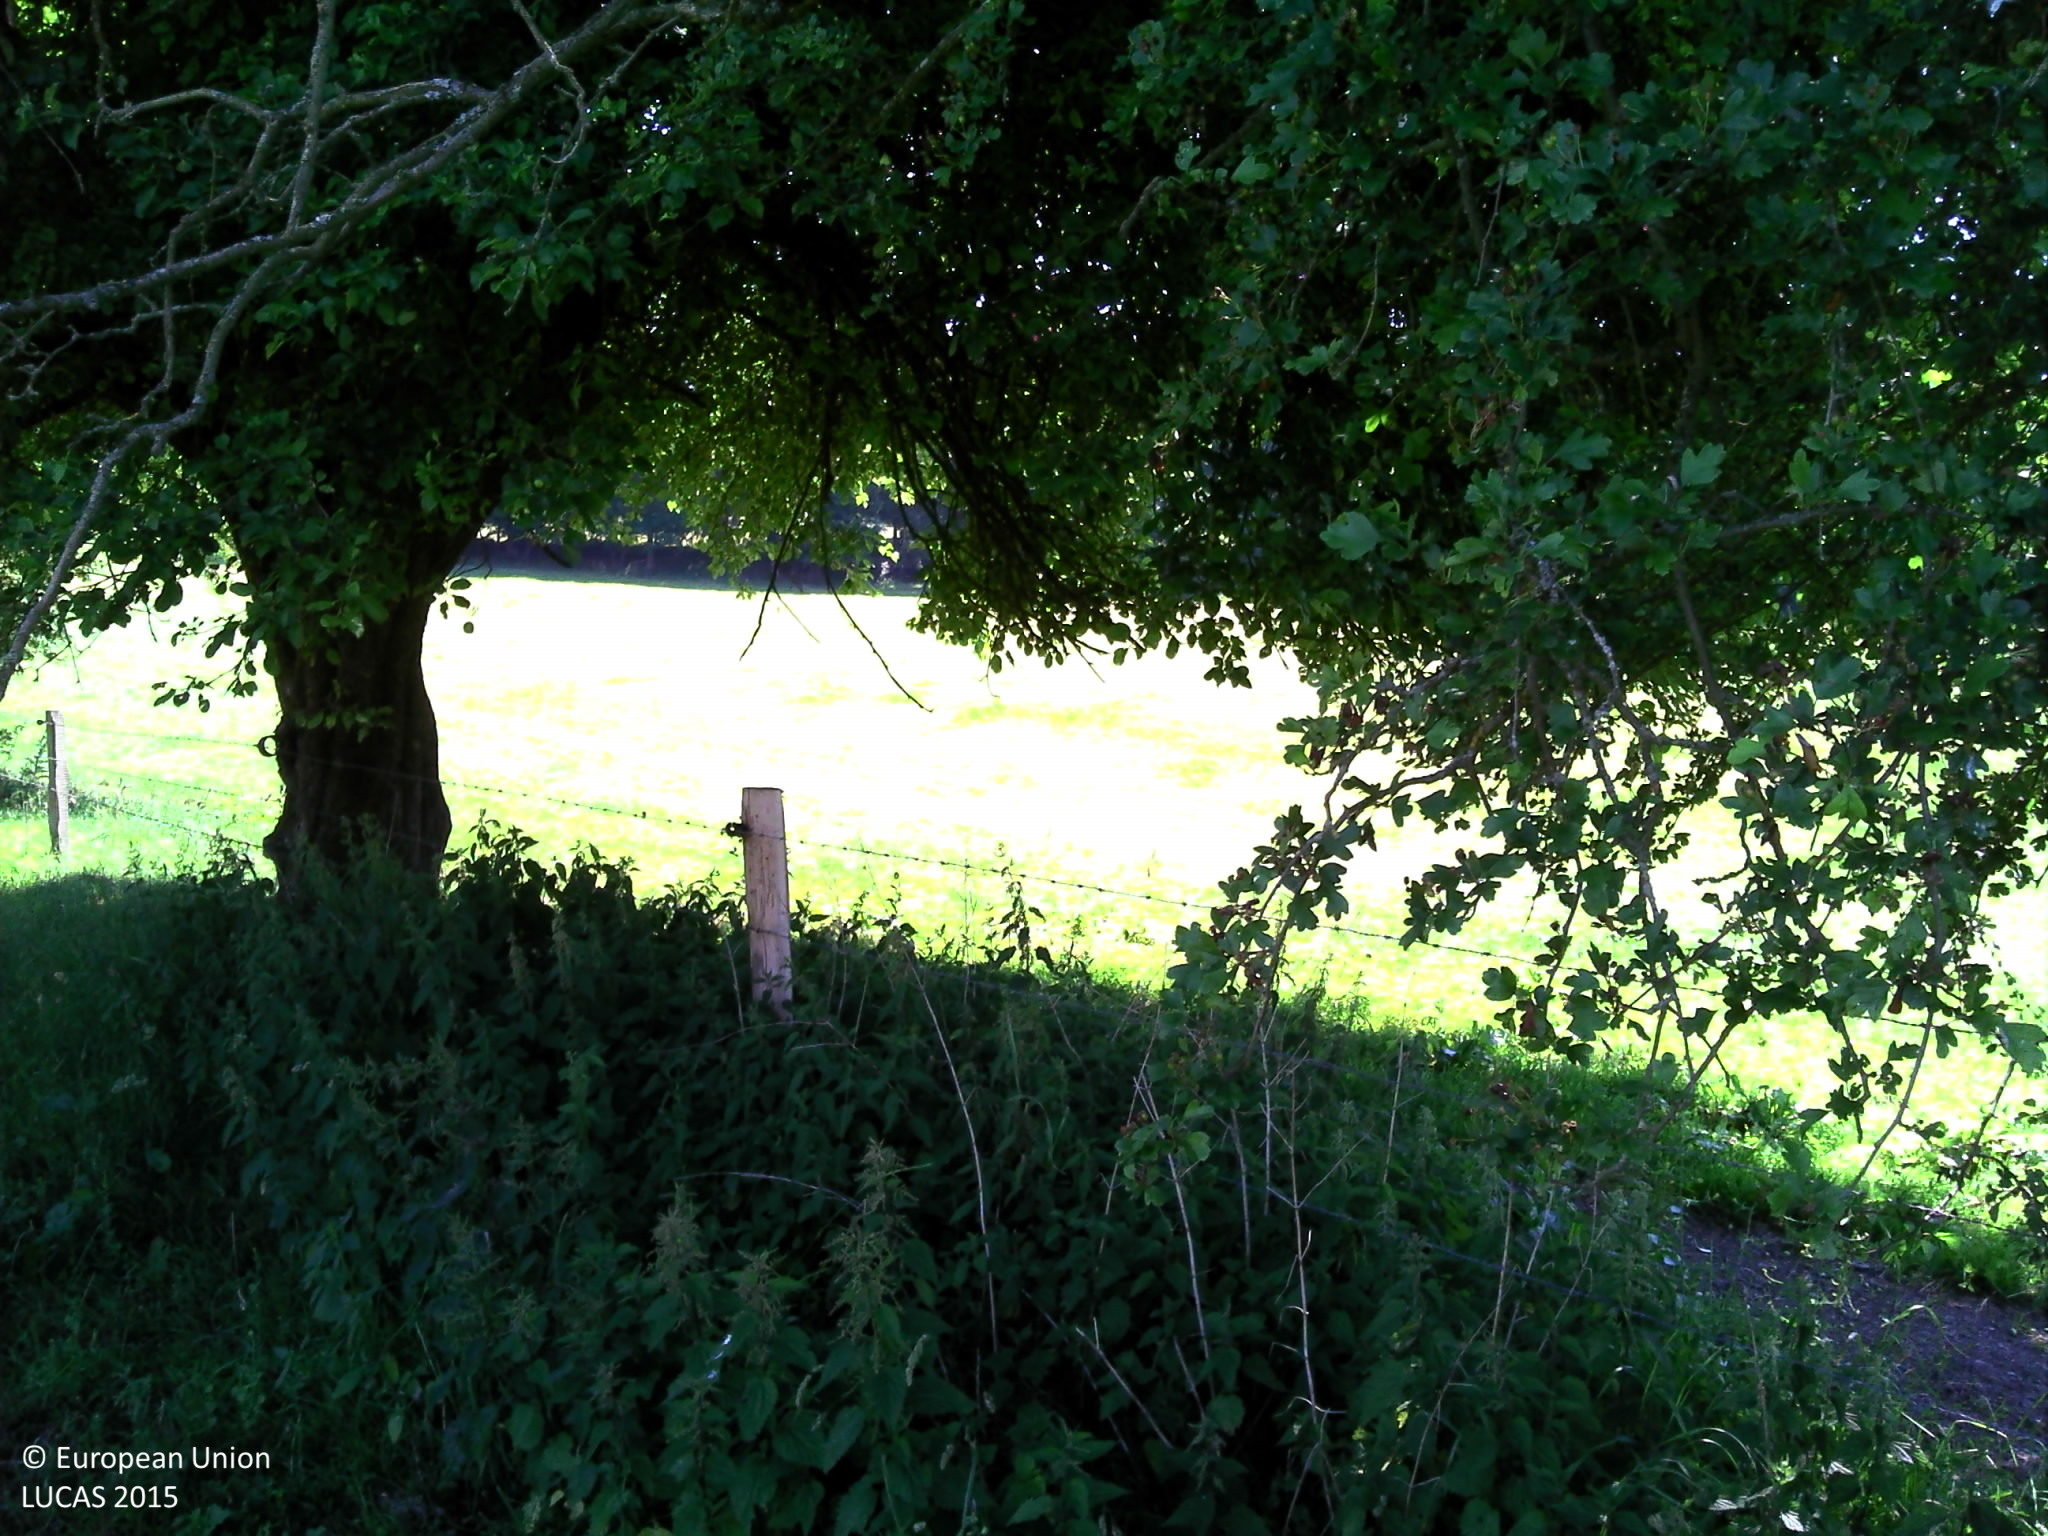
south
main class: Grassland
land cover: Grassland without tree/shrub cover
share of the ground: > 75 %
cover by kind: herbaceous plants 100 %
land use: Agriculture (excluding fallow land and kitchen gardens)
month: June
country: BE
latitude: 50.0611
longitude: 5.5423
